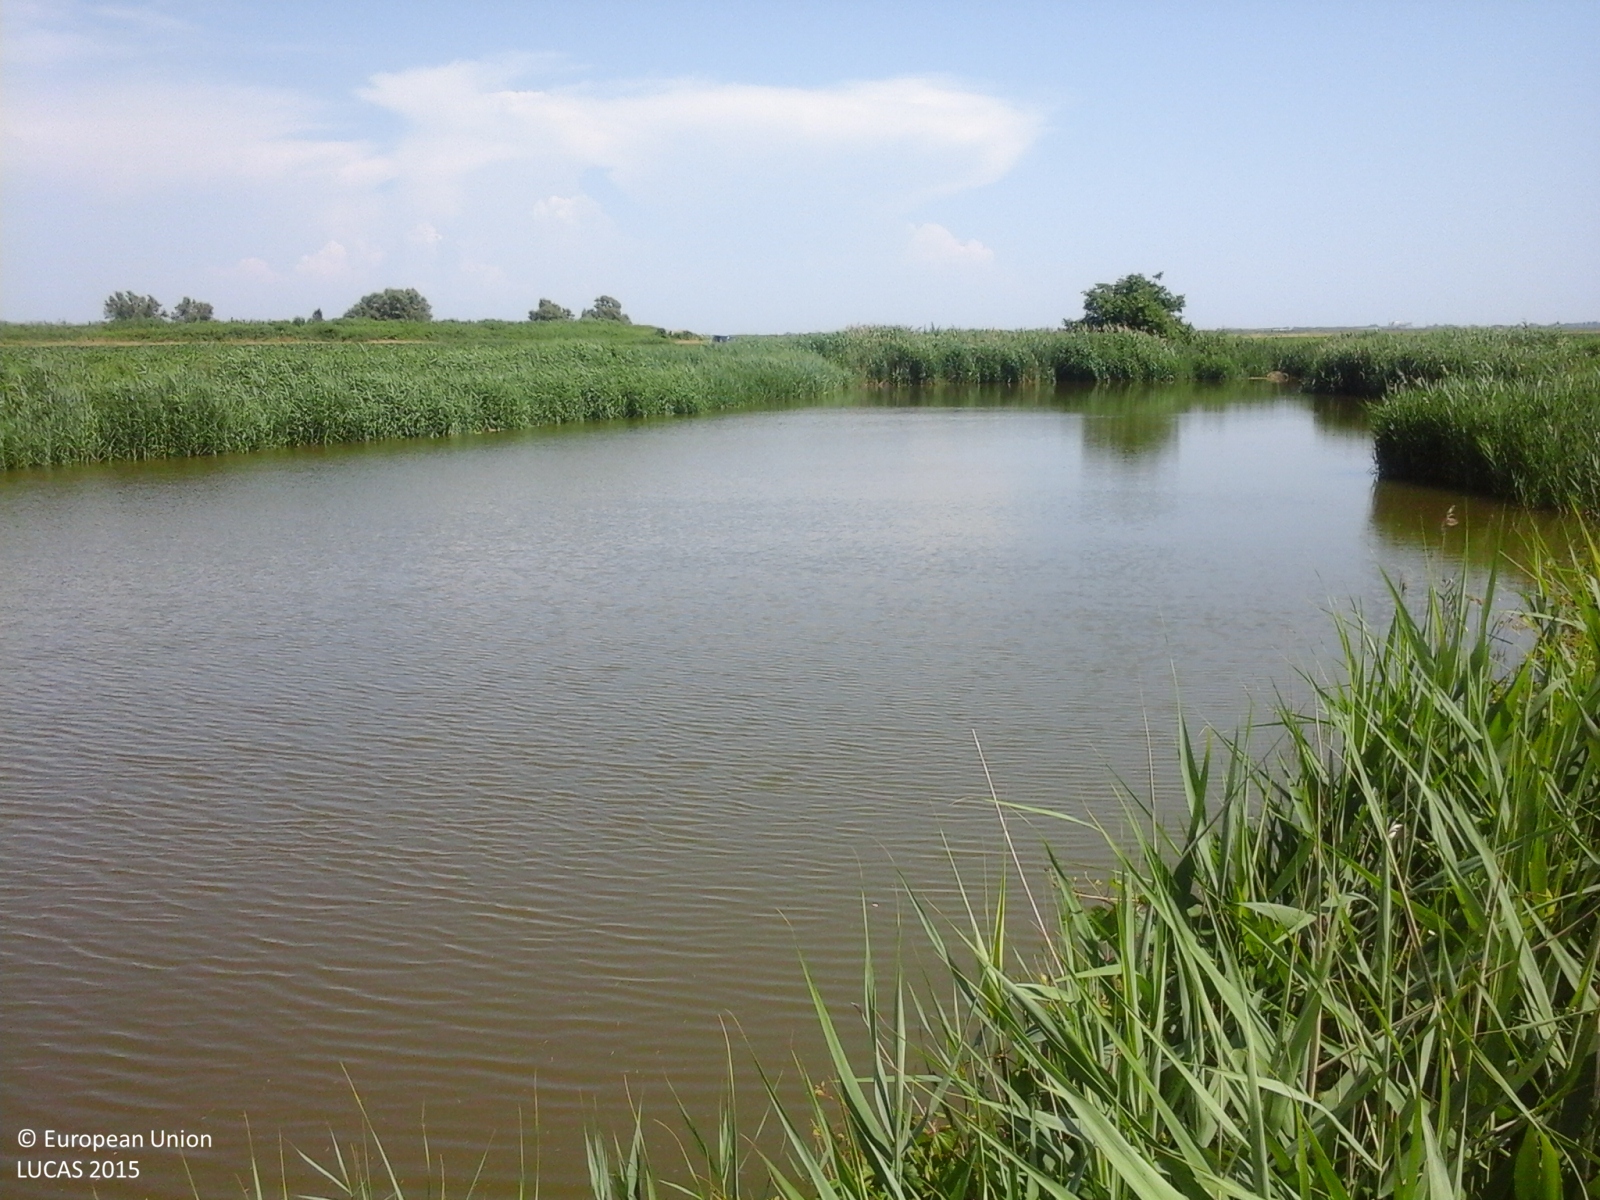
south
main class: Cropland
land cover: Maize
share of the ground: 25 - 50 %
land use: Agriculture (excluding fallow land and kitchen gardens)
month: June
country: IT
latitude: 45.6613
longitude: 12.9607
